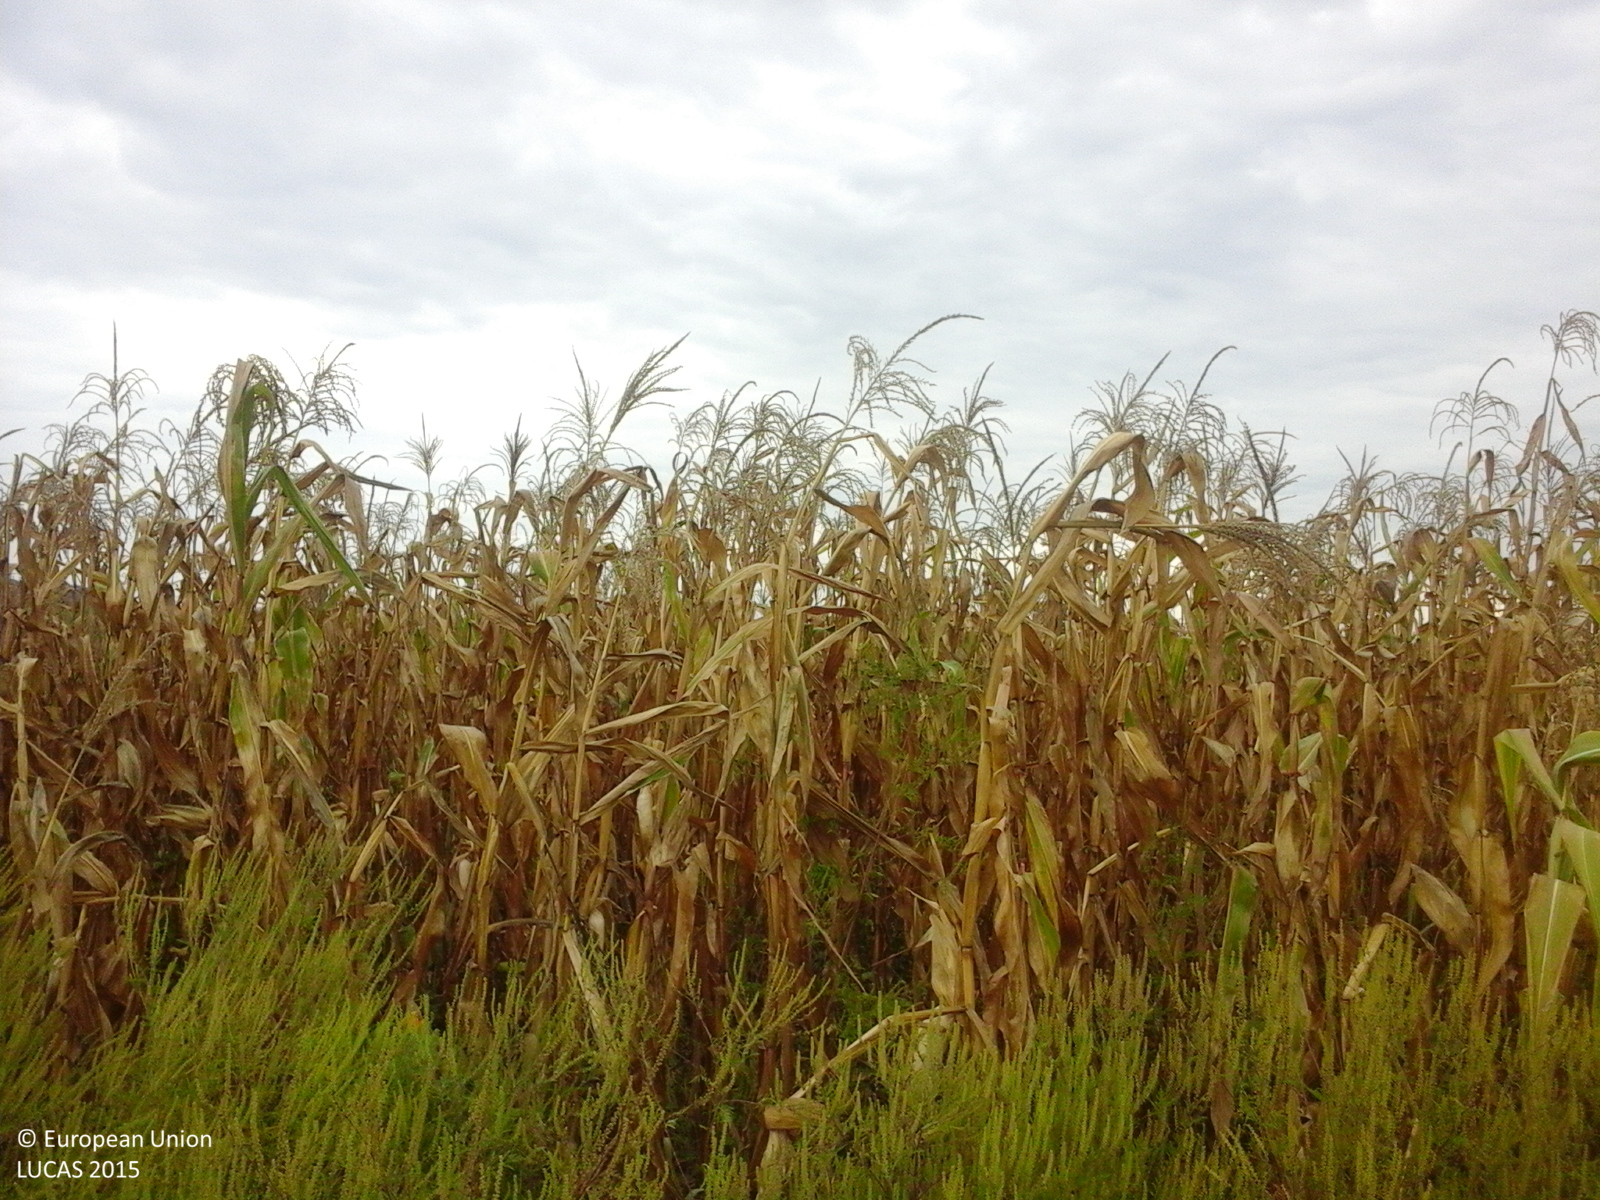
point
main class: Cropland
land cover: Maize
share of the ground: > 75 %
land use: Agriculture (excluding fallow land and kitchen gardens)
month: September
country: RO
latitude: 47.8425
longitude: 23.3686
